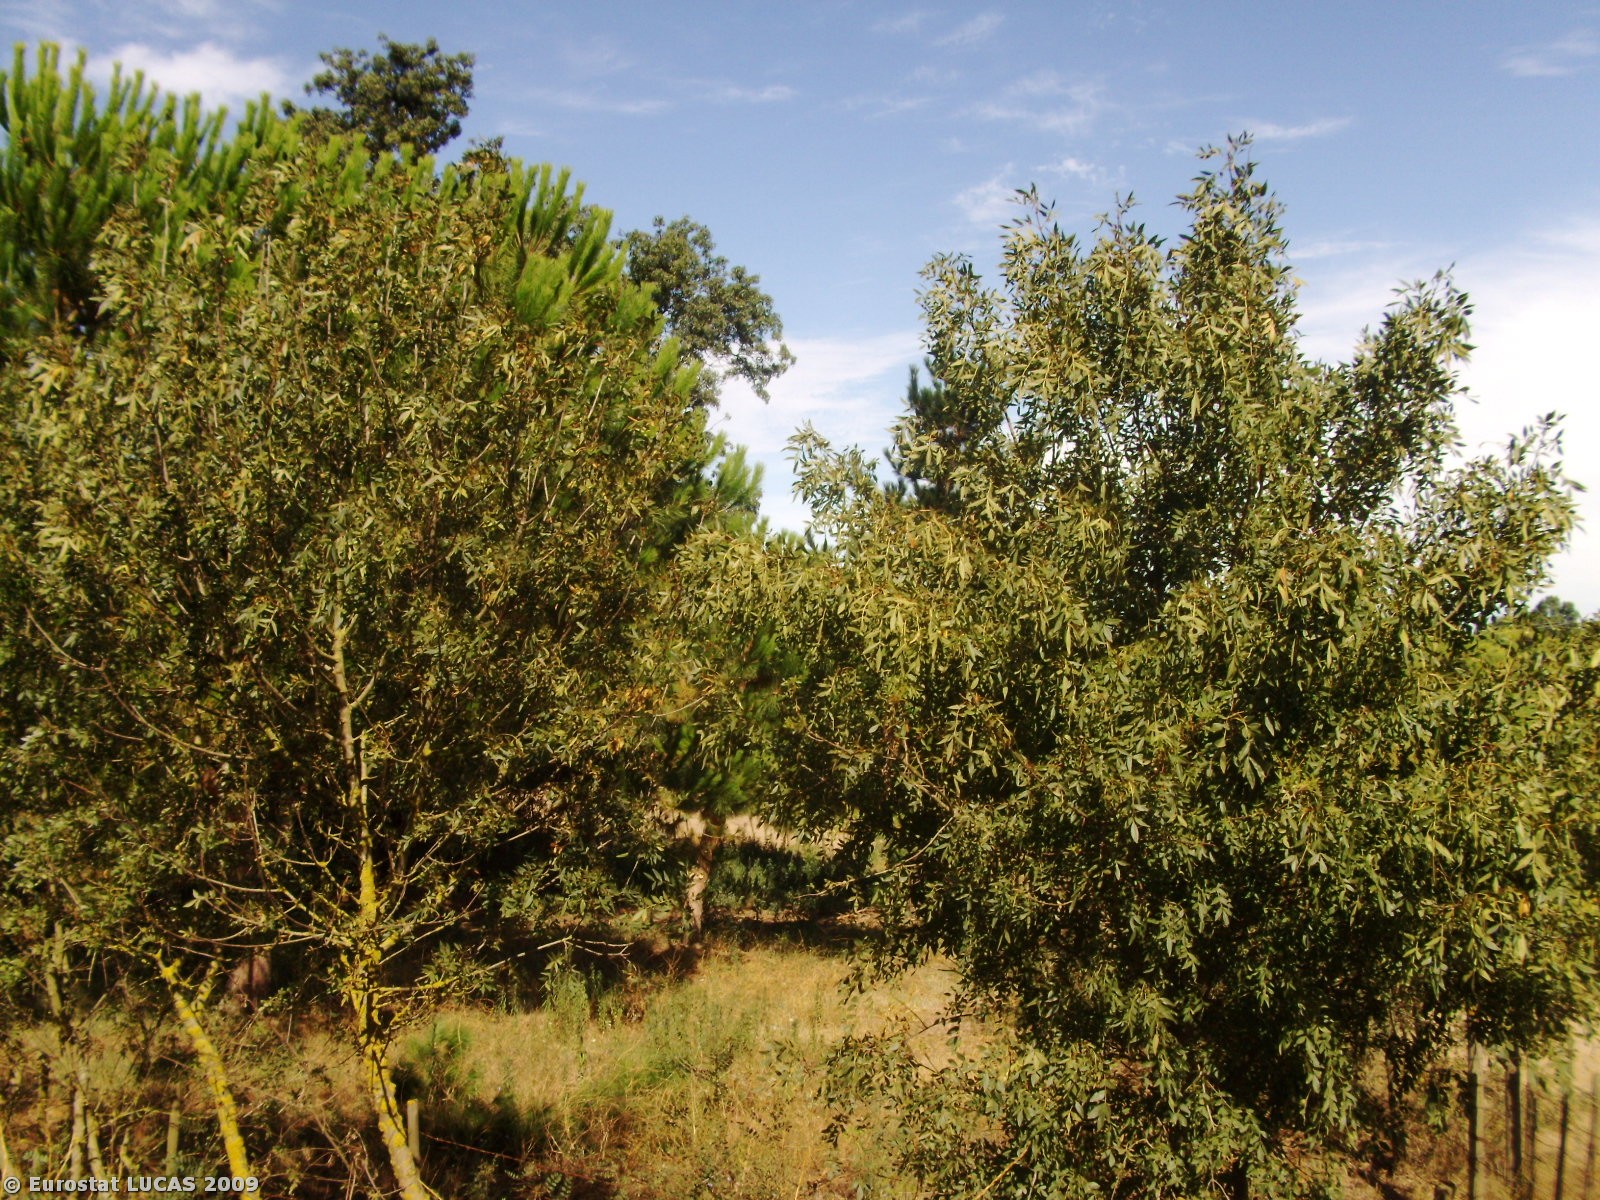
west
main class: Grassland
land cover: Grassland with sparse tree/shrub cover
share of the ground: 50 - 75 %
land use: Agriculture (excluding fallow land and kitchen gardens)
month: August
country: PT
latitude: 39.0423
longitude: -8.8004
